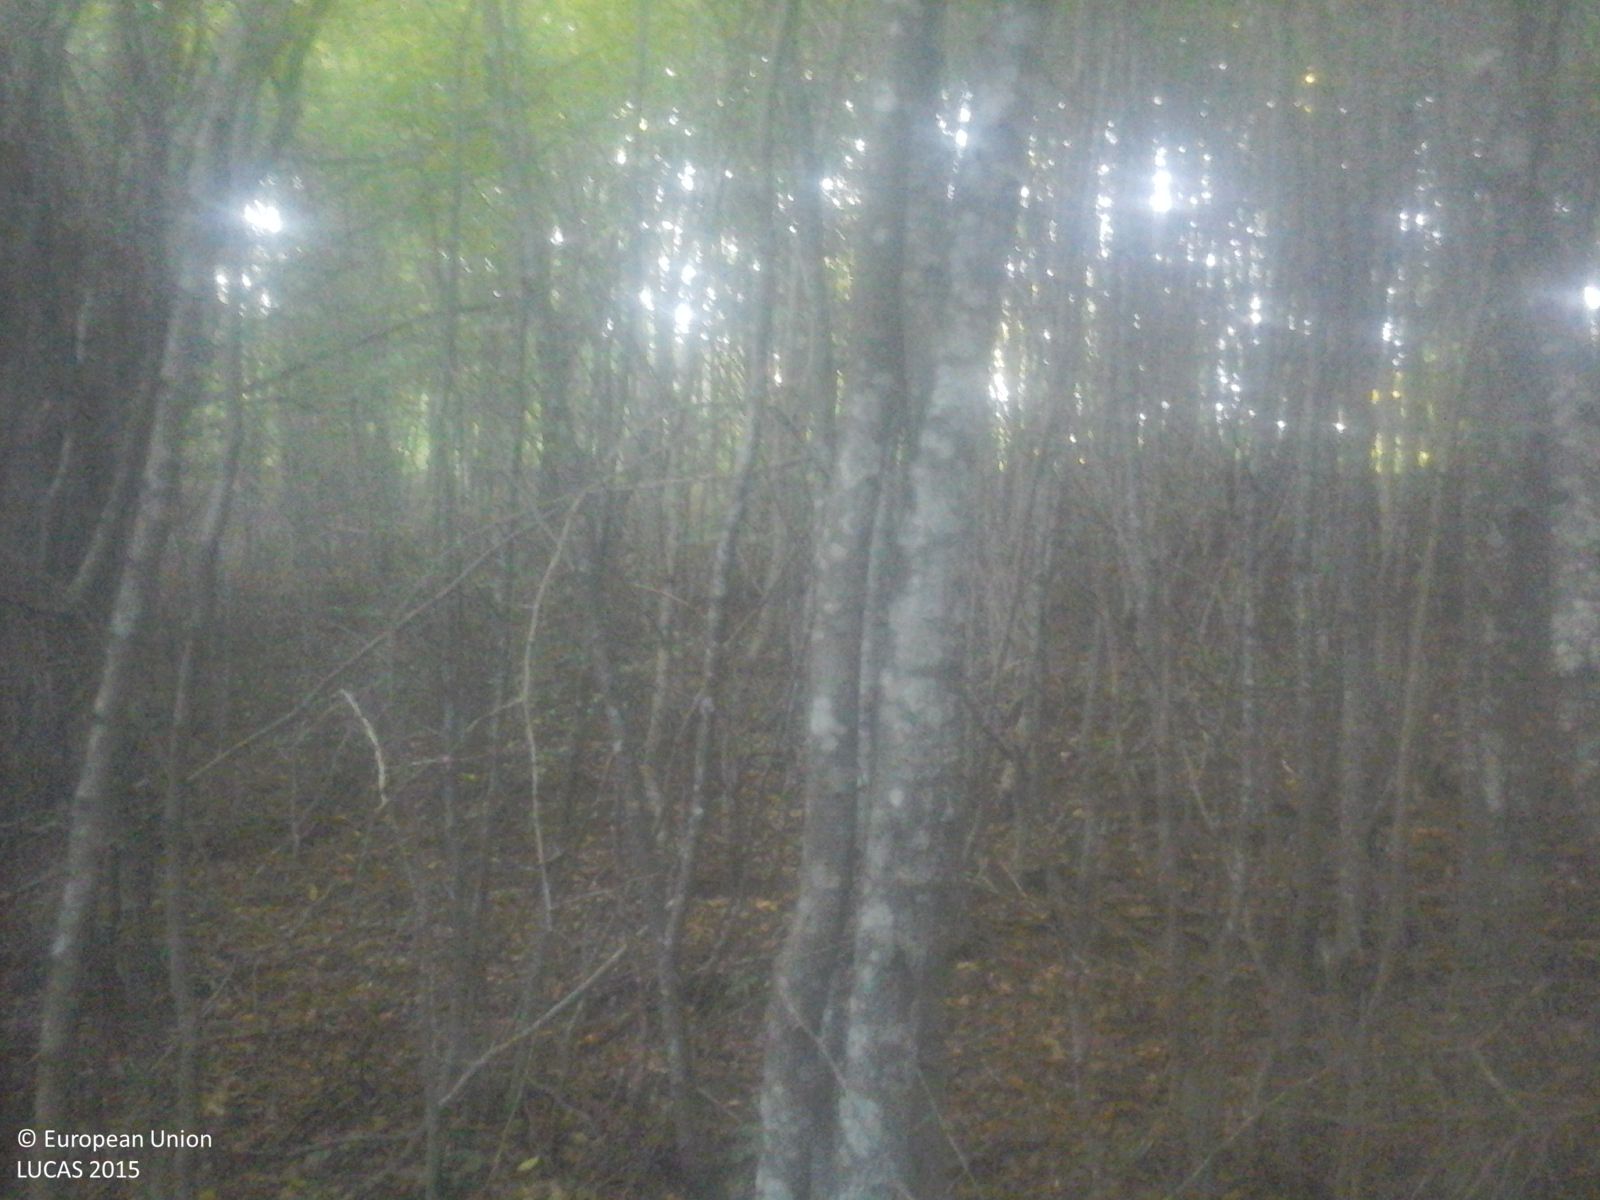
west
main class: Woodland
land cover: Broadleaved woodland
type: beech forest
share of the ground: > 75 %
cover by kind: broadleaved forest trees 100 %
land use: Forestry
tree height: > 5 m
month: October
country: RO
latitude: 46.4845
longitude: 23.5775
